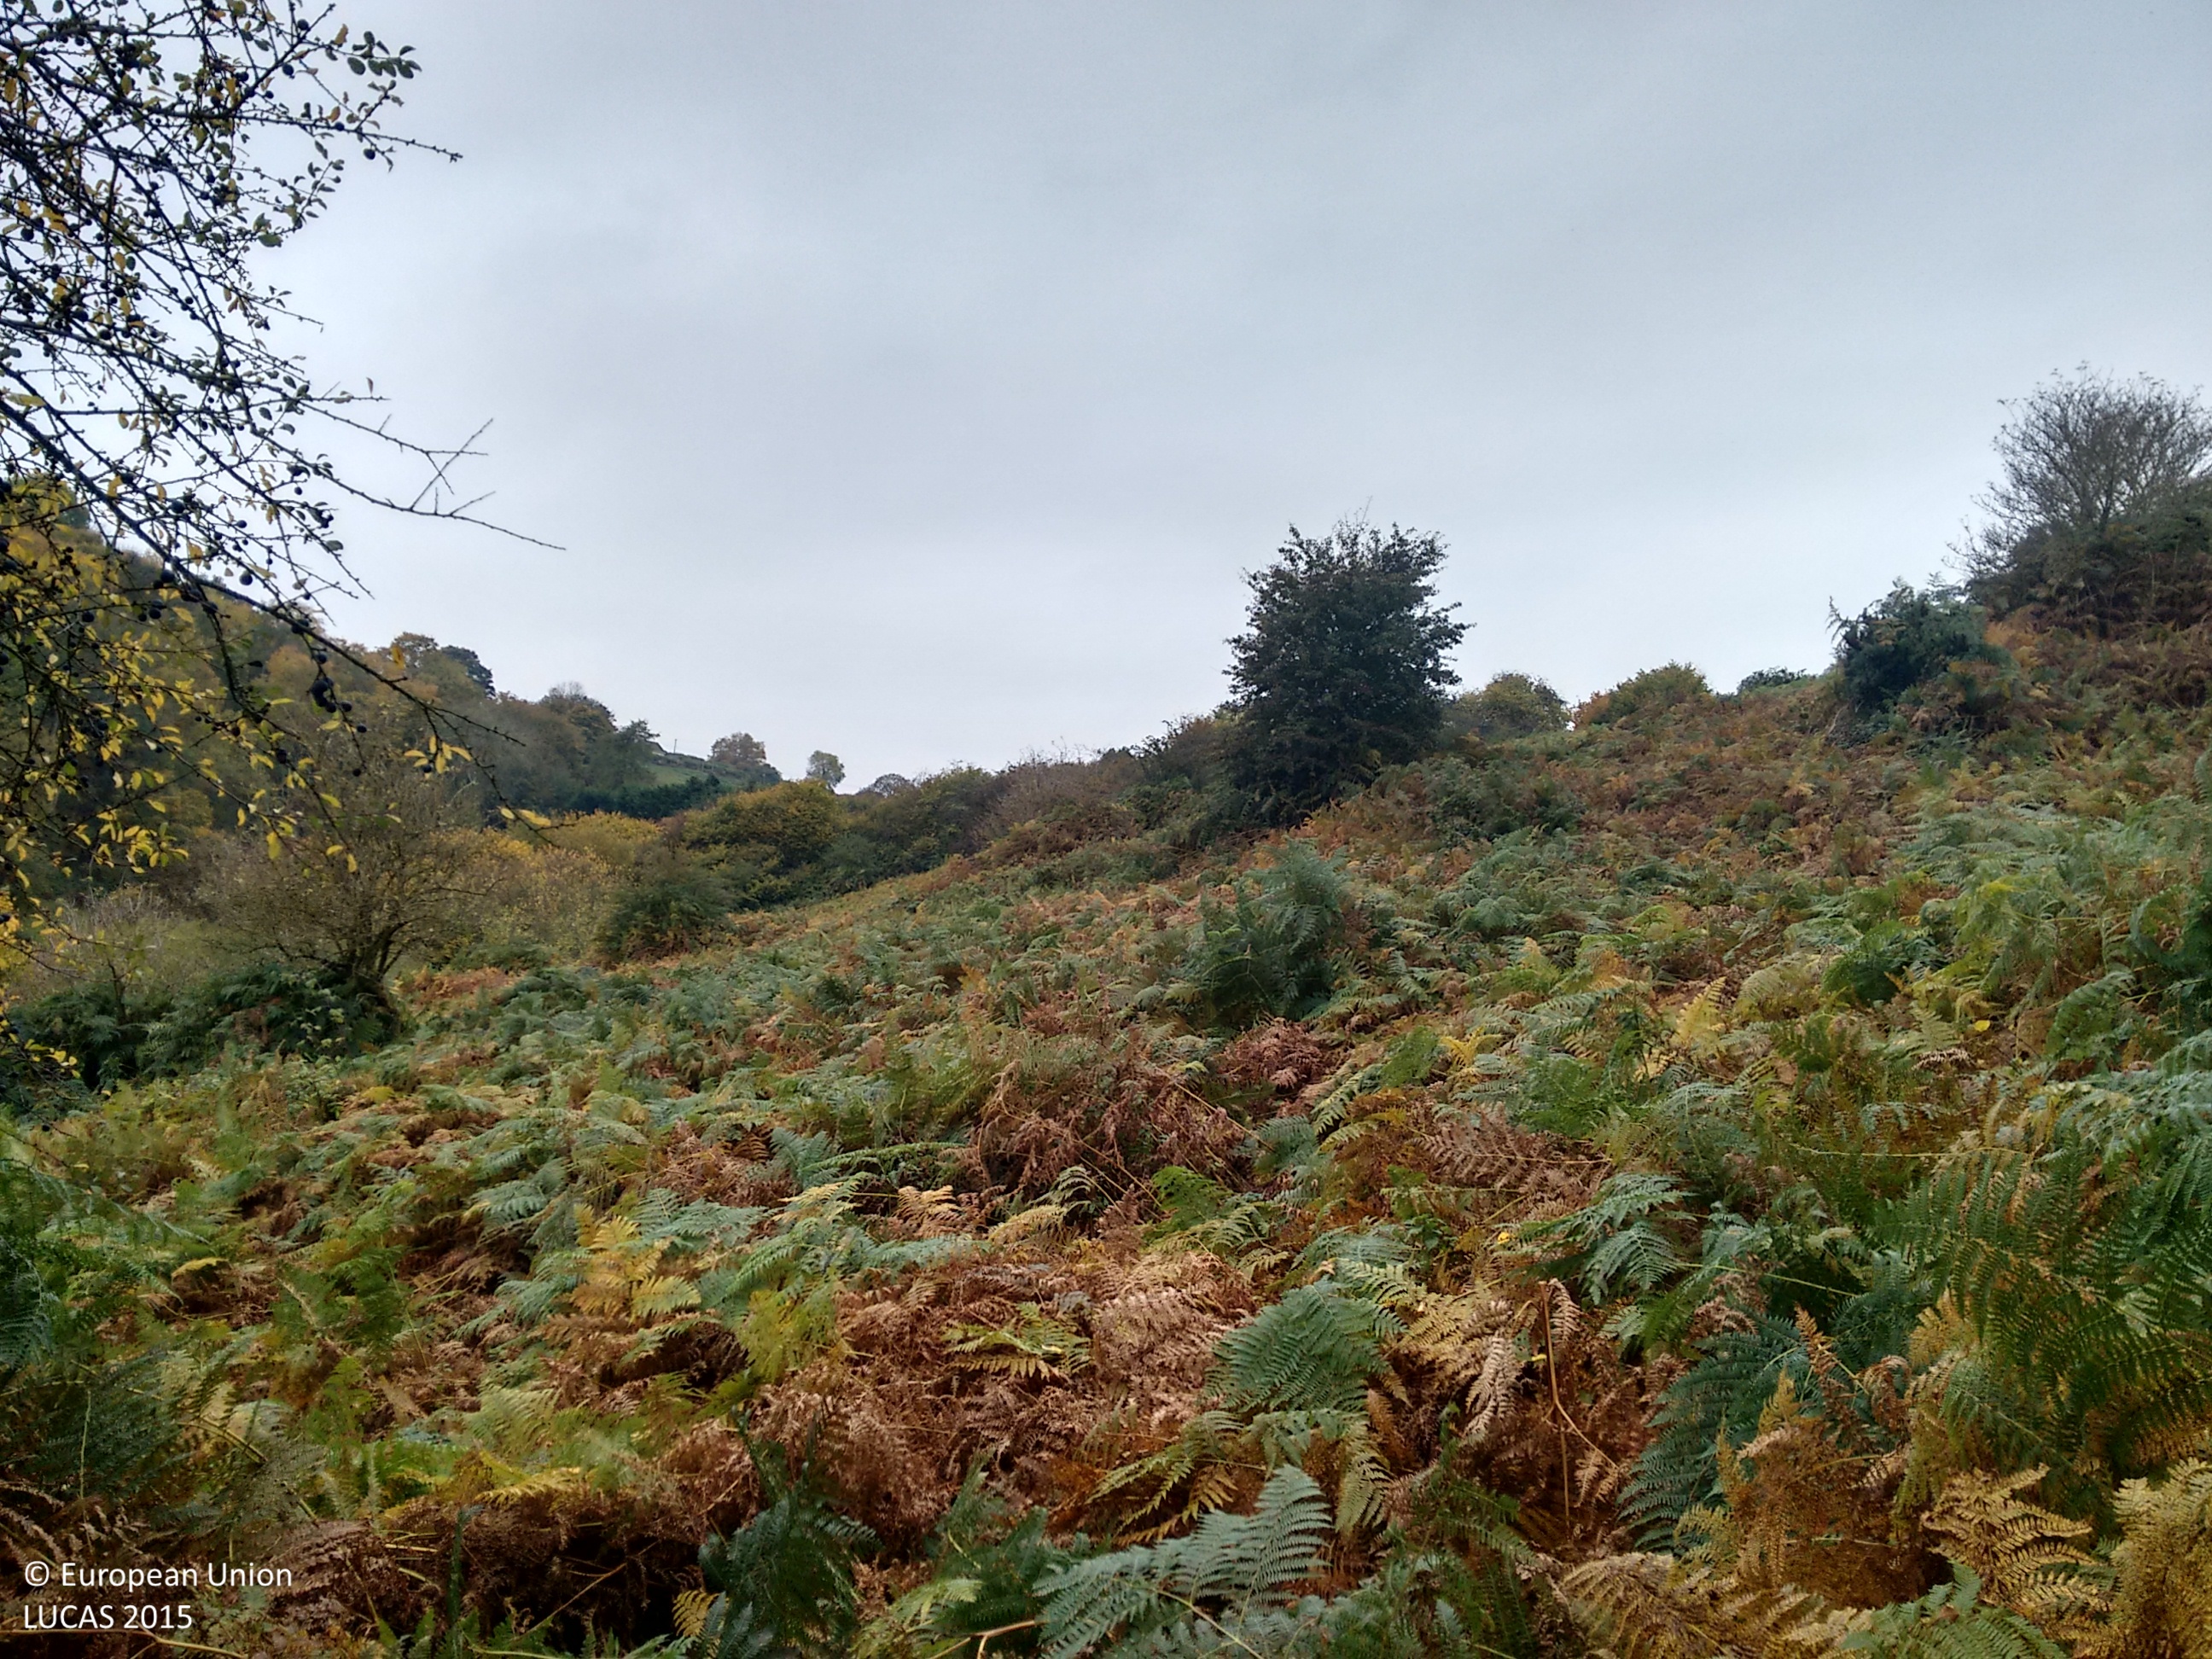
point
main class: Shrubland
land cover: Shrubland without tree cover
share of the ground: > 75 %
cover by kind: herbaceous plants 80 %, shrubs 20 %
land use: Semi-natural and natural areas not in use
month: October
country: GB
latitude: 52.4044
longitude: -2.8456
